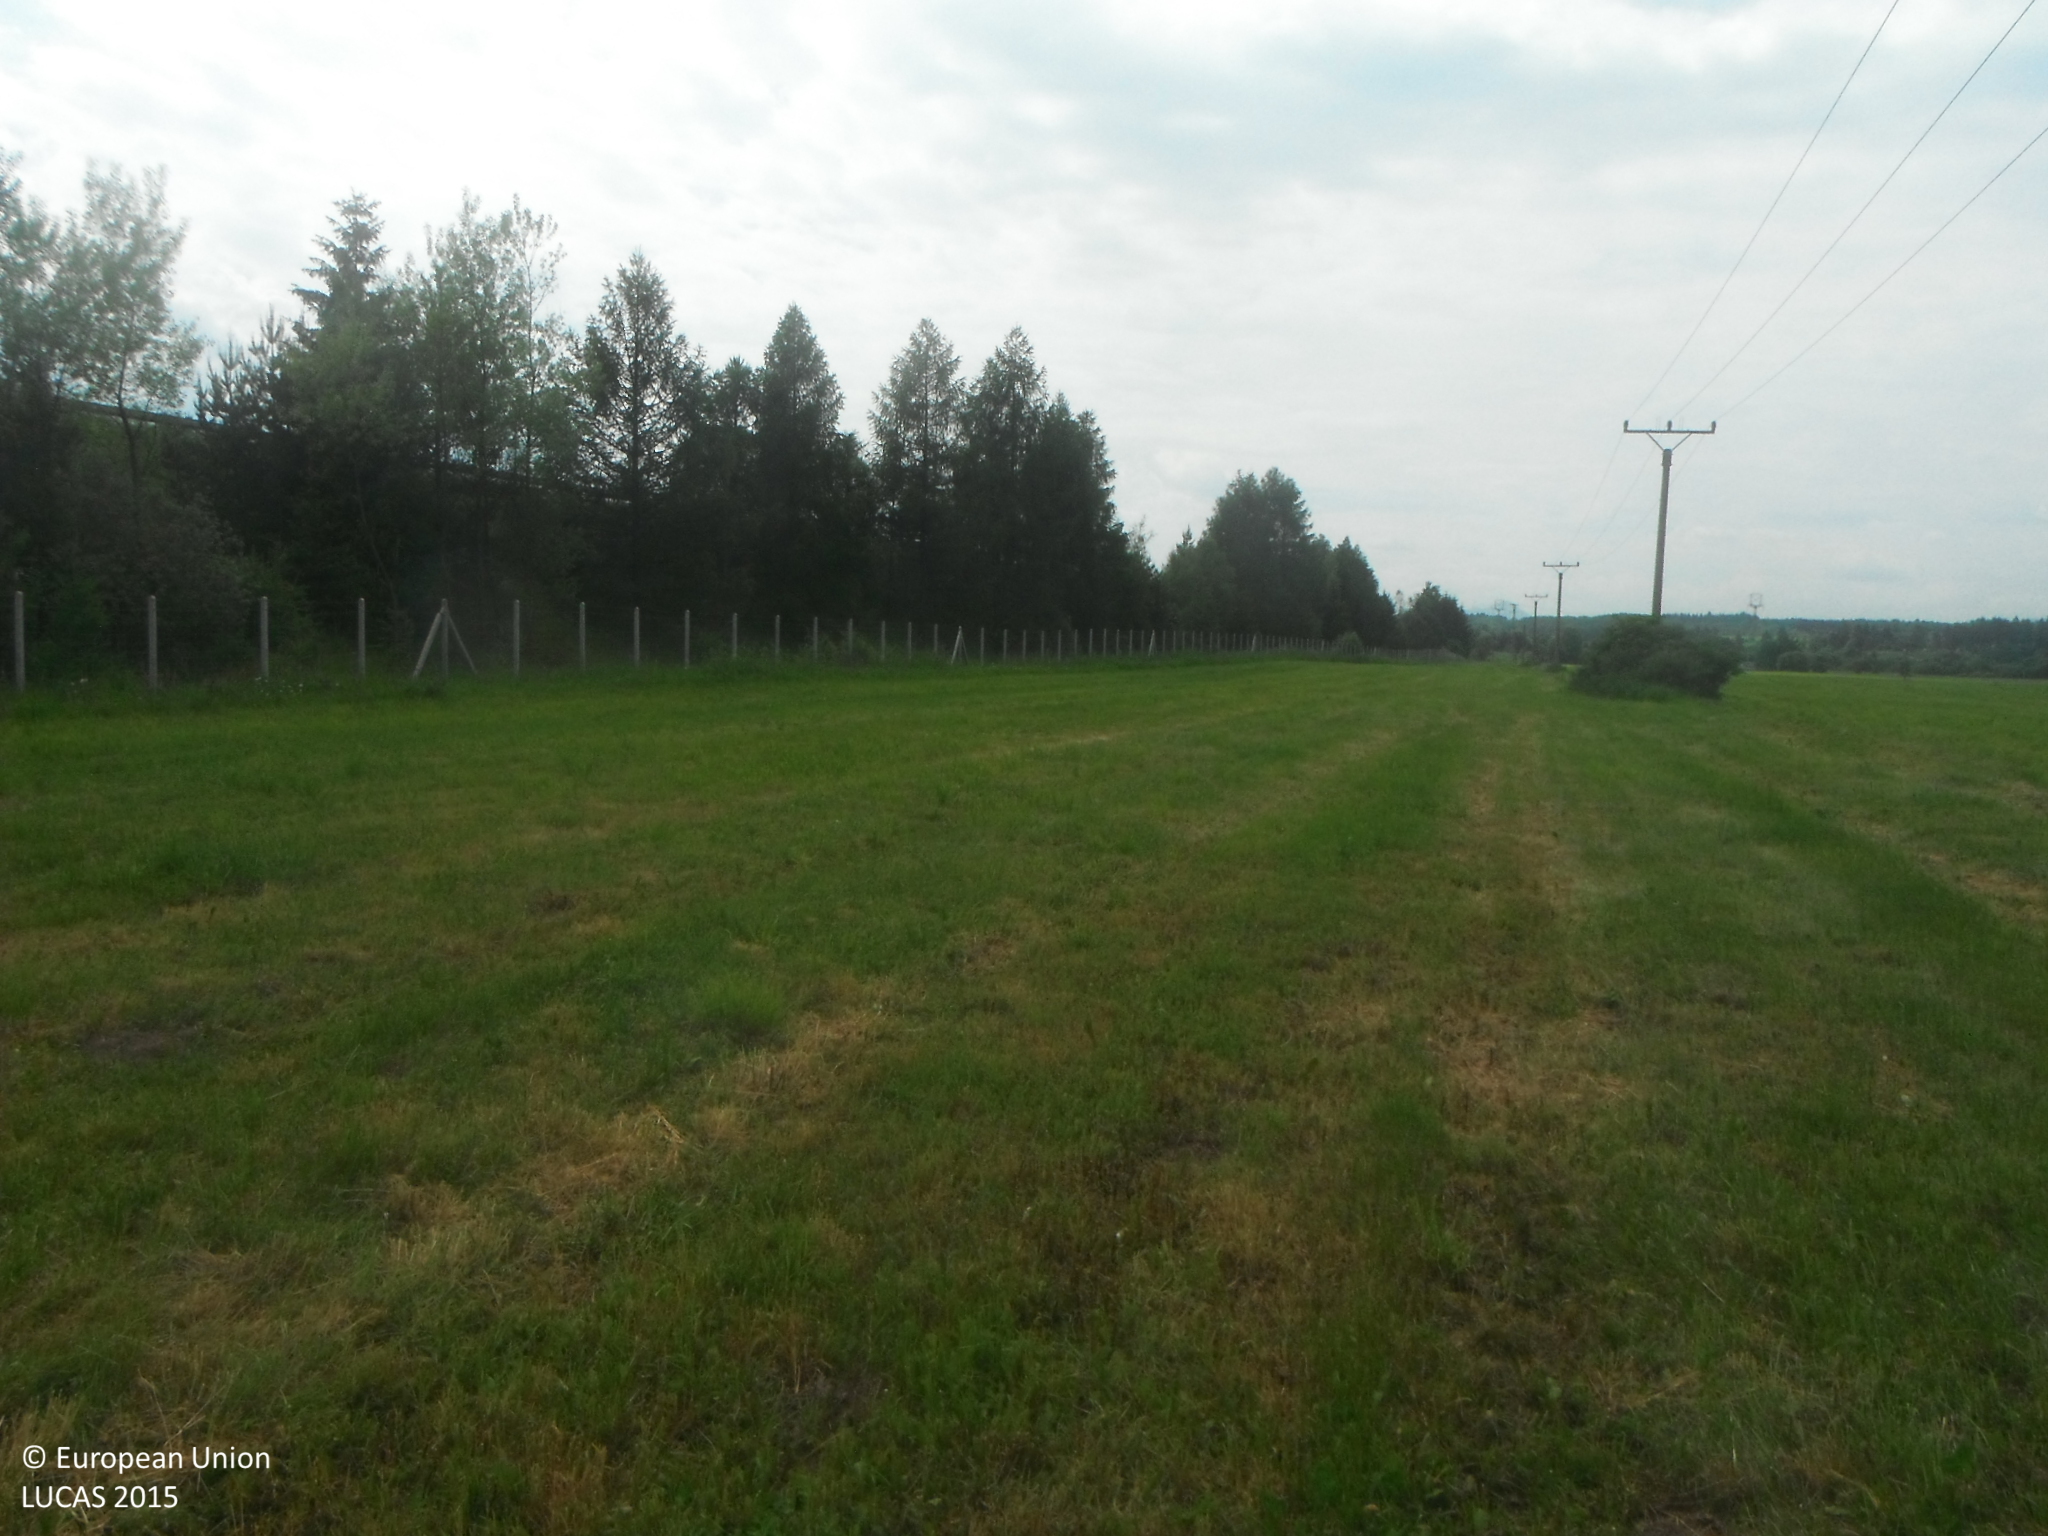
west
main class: Grassland
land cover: Grassland without tree/shrub cover
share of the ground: > 75 %
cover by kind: herbaceous plants 100 %
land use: Agriculture (excluding fallow land and kitchen gardens)
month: June
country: SK
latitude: 49.0581
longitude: 19.7583
